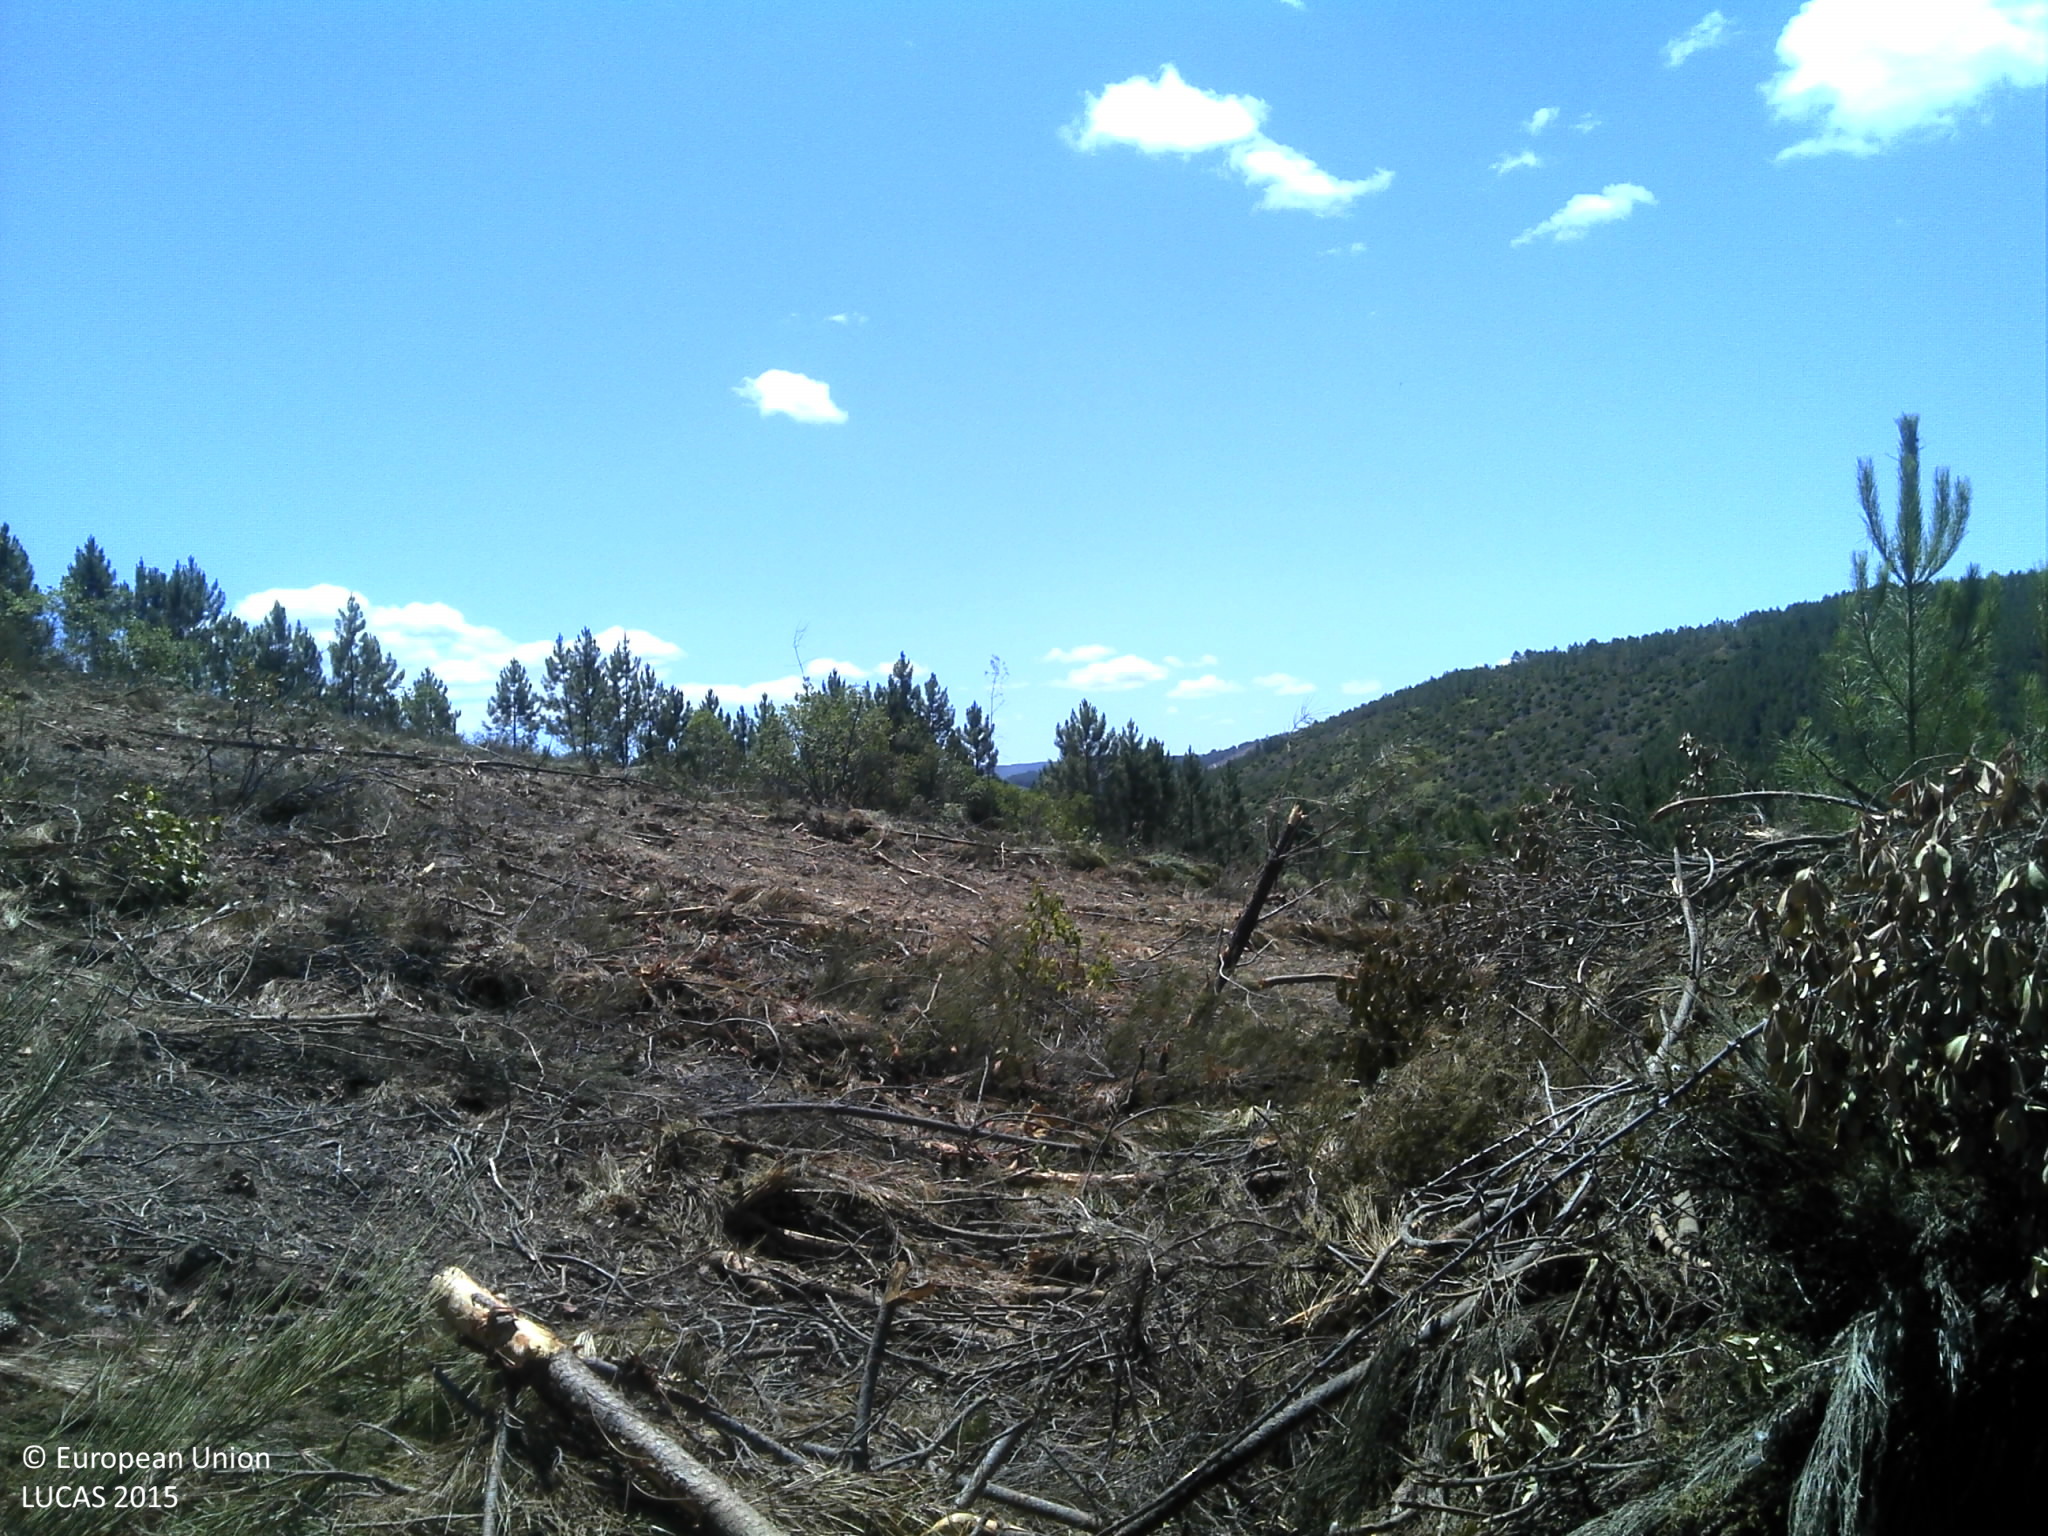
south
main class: Shrubland
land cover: Shrubland without tree cover
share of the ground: 50 - 75 %
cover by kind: shrubs 70 %, herbaceous plants 10 %, unconsolidated bare surface 10 %
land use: Forestry
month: July
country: PT
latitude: 40.1870
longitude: -7.7415
